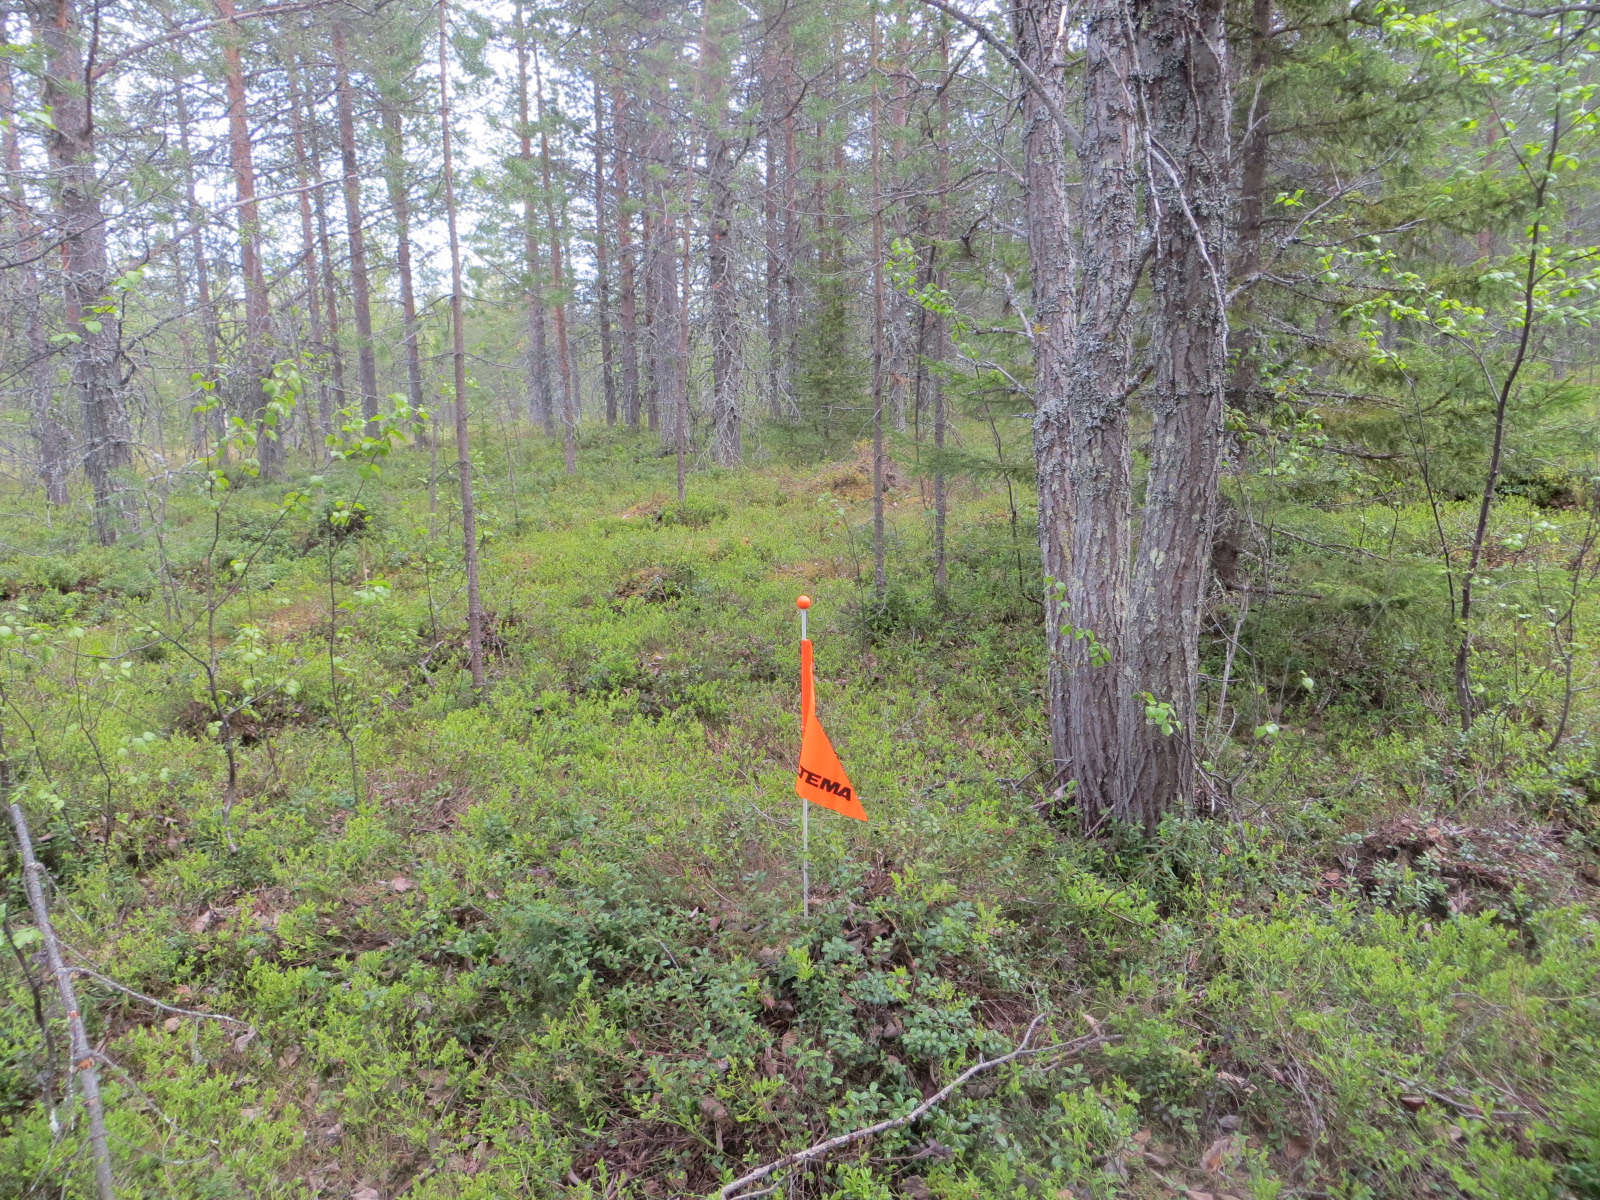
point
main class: Woodland
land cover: Pine dominated coniferous woodland
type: boreal forest
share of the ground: > 75 %
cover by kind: coniferous forest trees 70 %, broadleaved forest trees 15 %, shrubs 10 %, lichens and mosses 5 %
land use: Forestry
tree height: > 5 m
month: June
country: FI
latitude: 67.2930
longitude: 26.1539
